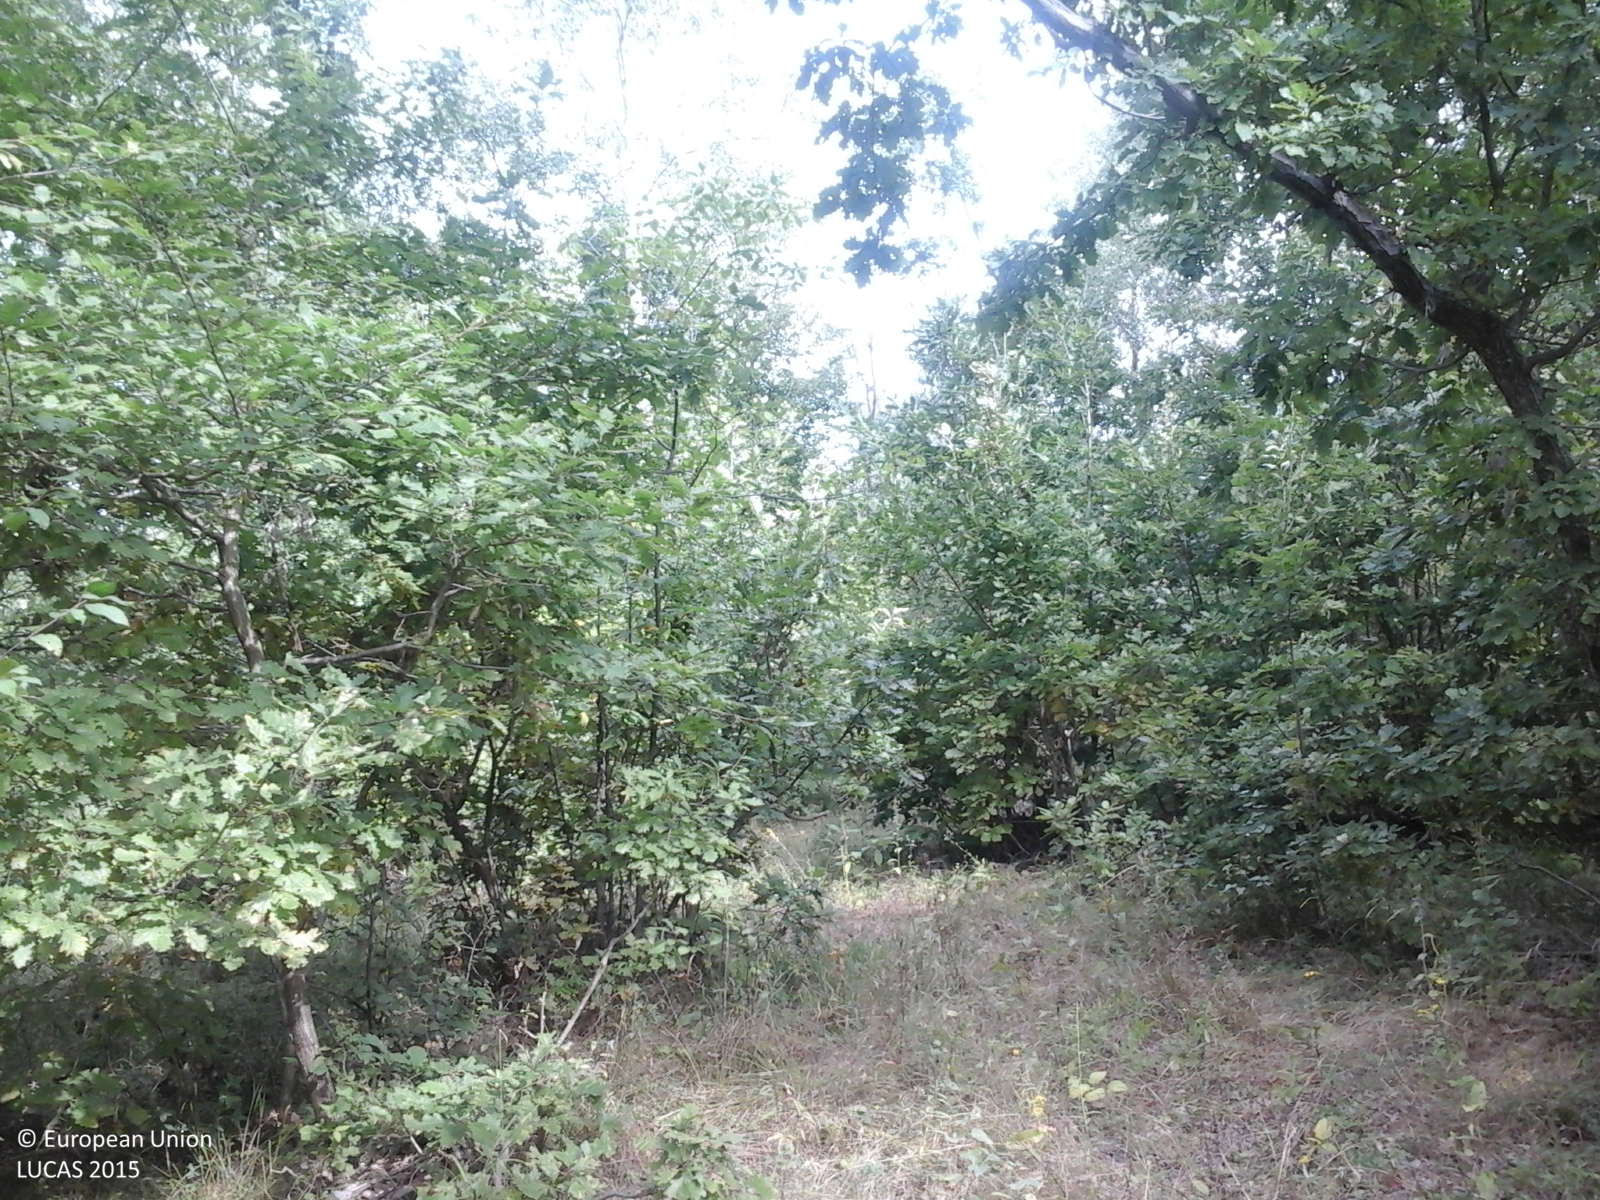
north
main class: Woodland
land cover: Broadleaved woodland
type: acidophilous oak and oak-birch forest
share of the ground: > 75 %
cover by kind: broadleaved forest trees 100 %
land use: Forestry
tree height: > 5 m
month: September
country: RO
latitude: 46.6566
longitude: 23.5157
